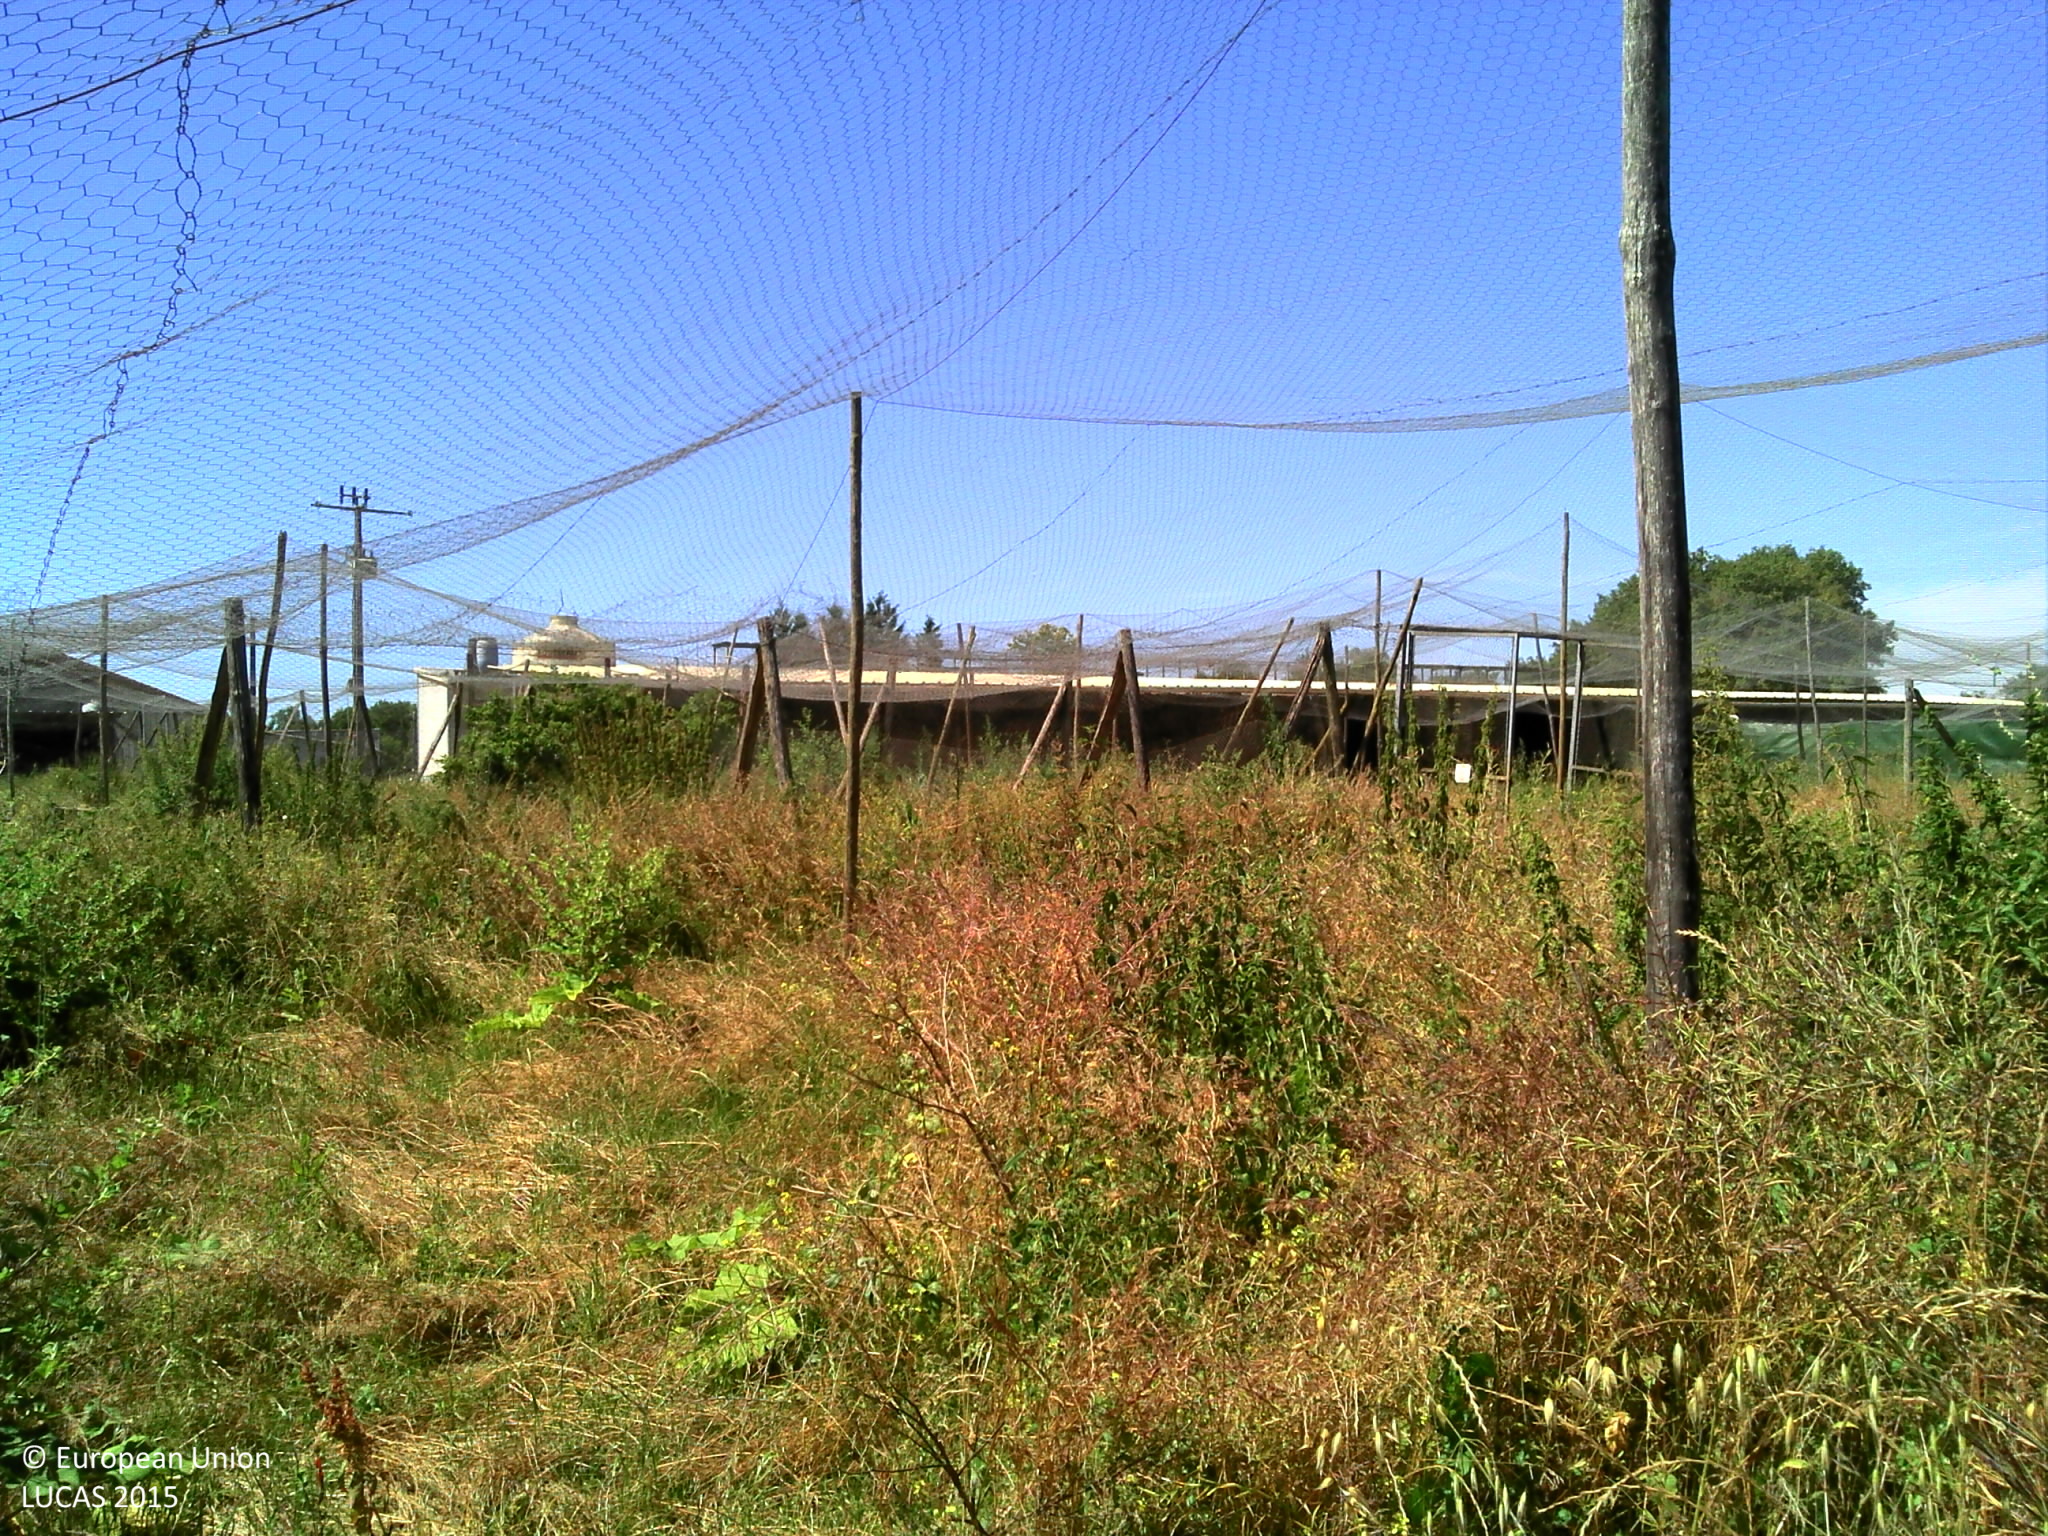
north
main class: Grassland
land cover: Grassland with sparse tree/shrub cover
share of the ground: > 75 %
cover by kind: herbaceous plants 95 %, broadleaved forest trees 5 %
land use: Agriculture (excluding fallow land and kitchen gardens)
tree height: < 5 m
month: June
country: FR
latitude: 45.5596
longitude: 0.4420
